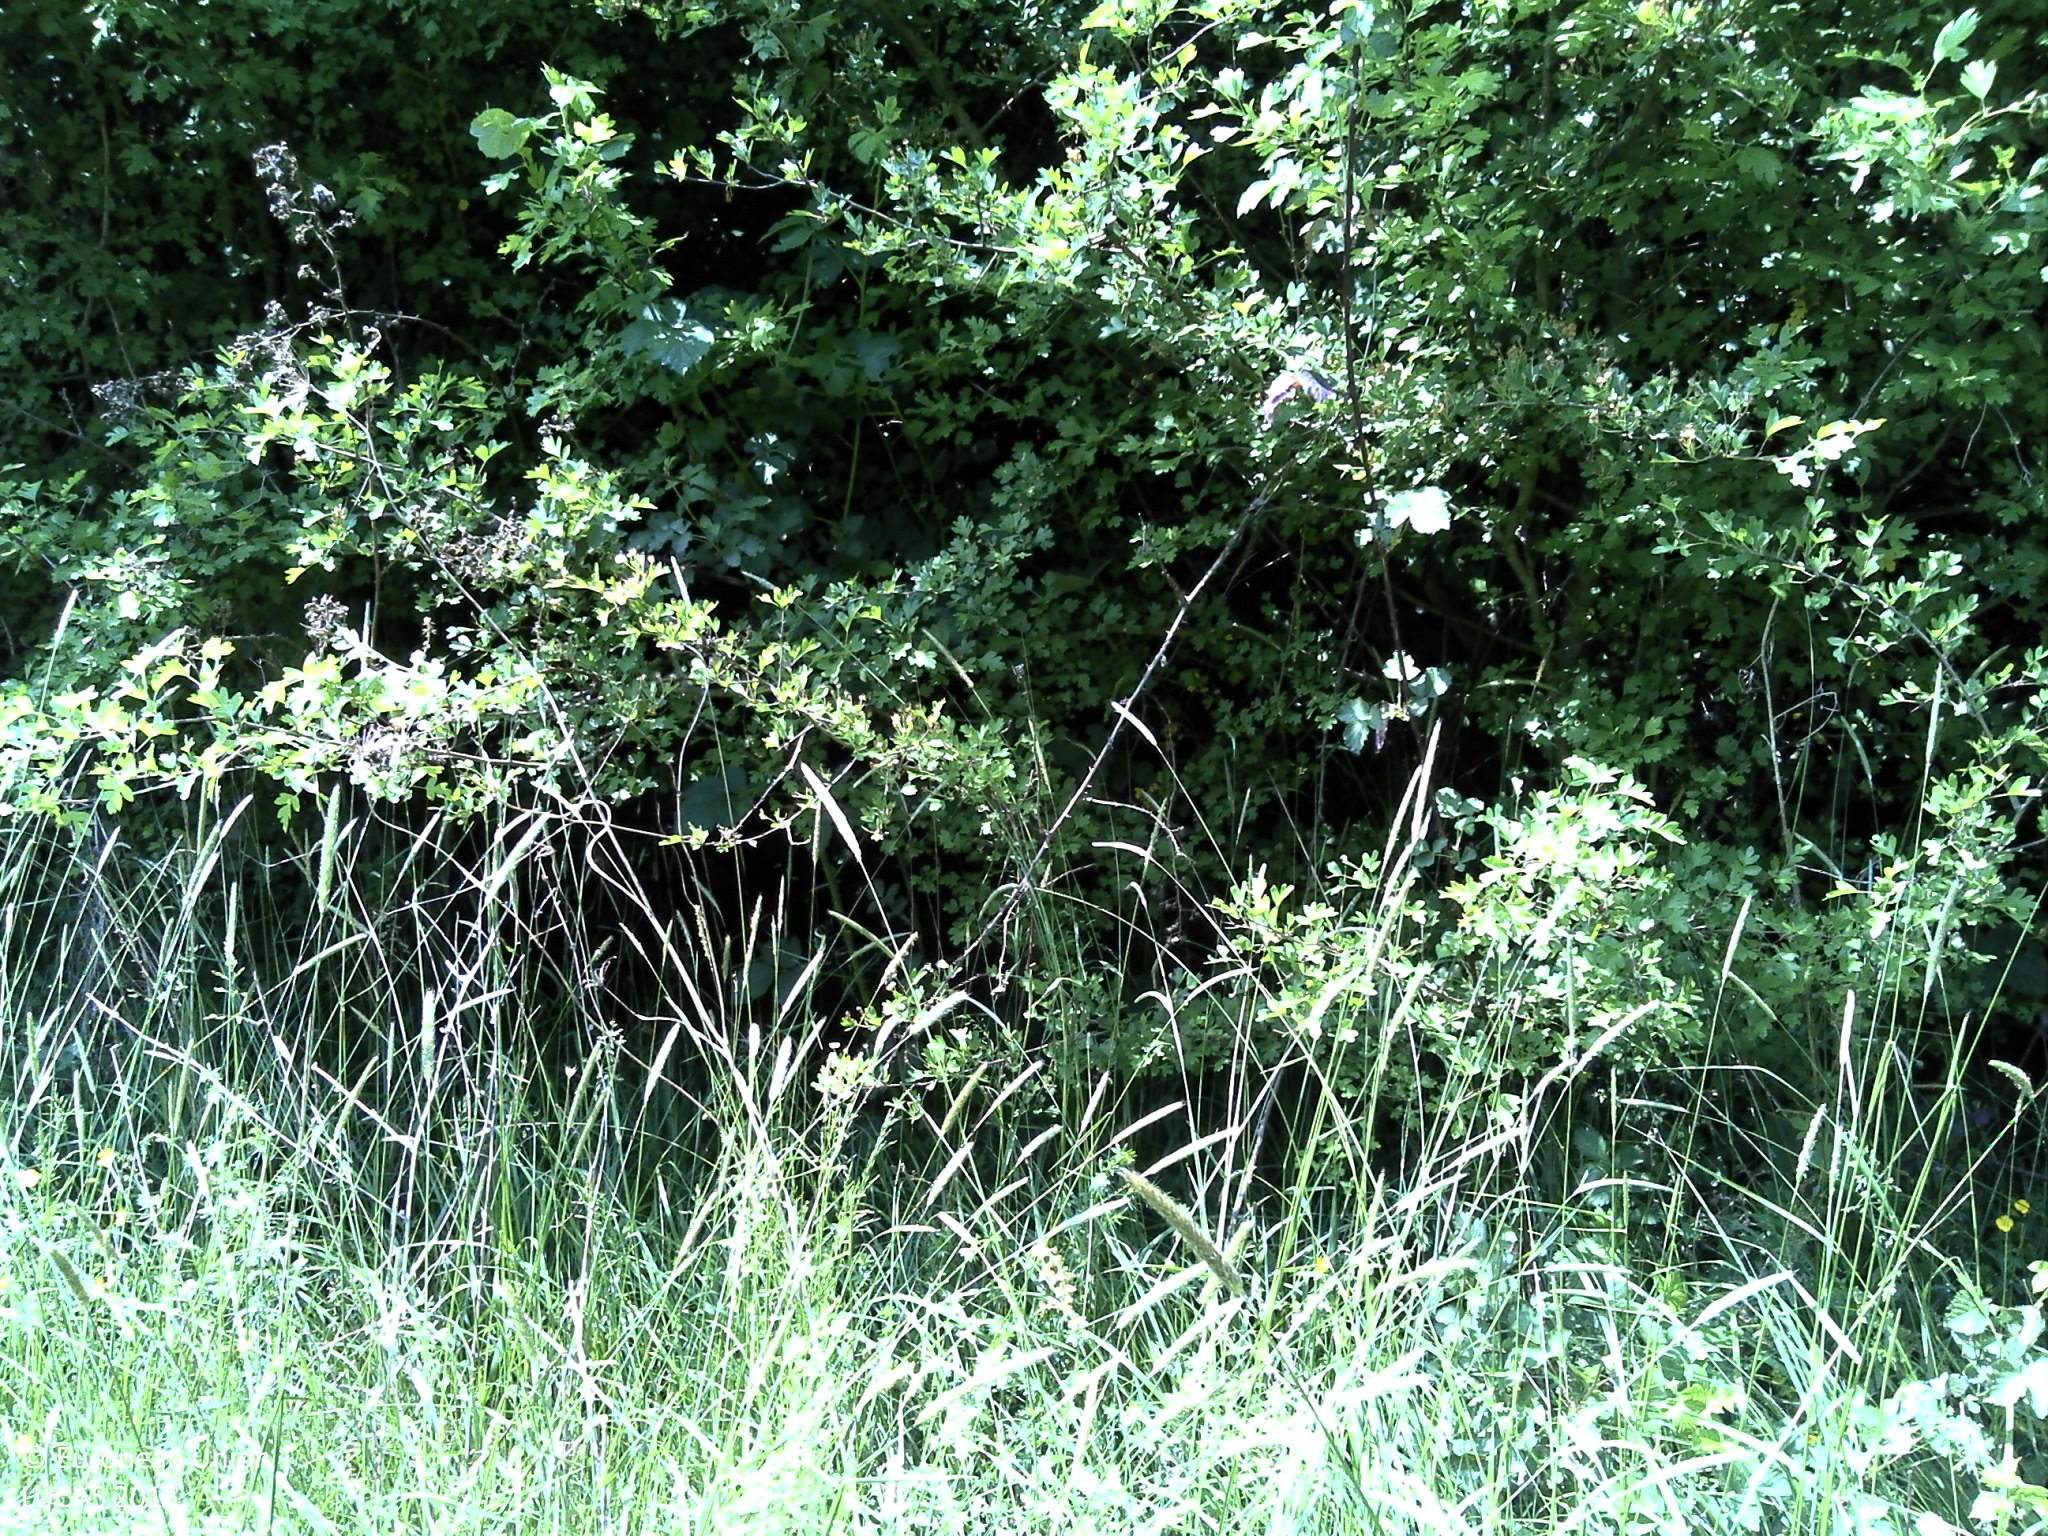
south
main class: Shrubland
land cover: Shrubland with sparse tree cover
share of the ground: > 75 %
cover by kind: shrubs 95 %, broadleaved forest trees 5 %
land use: Forestry
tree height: > 5 m
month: May
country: HR
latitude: 45.6236
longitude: 18.1493
